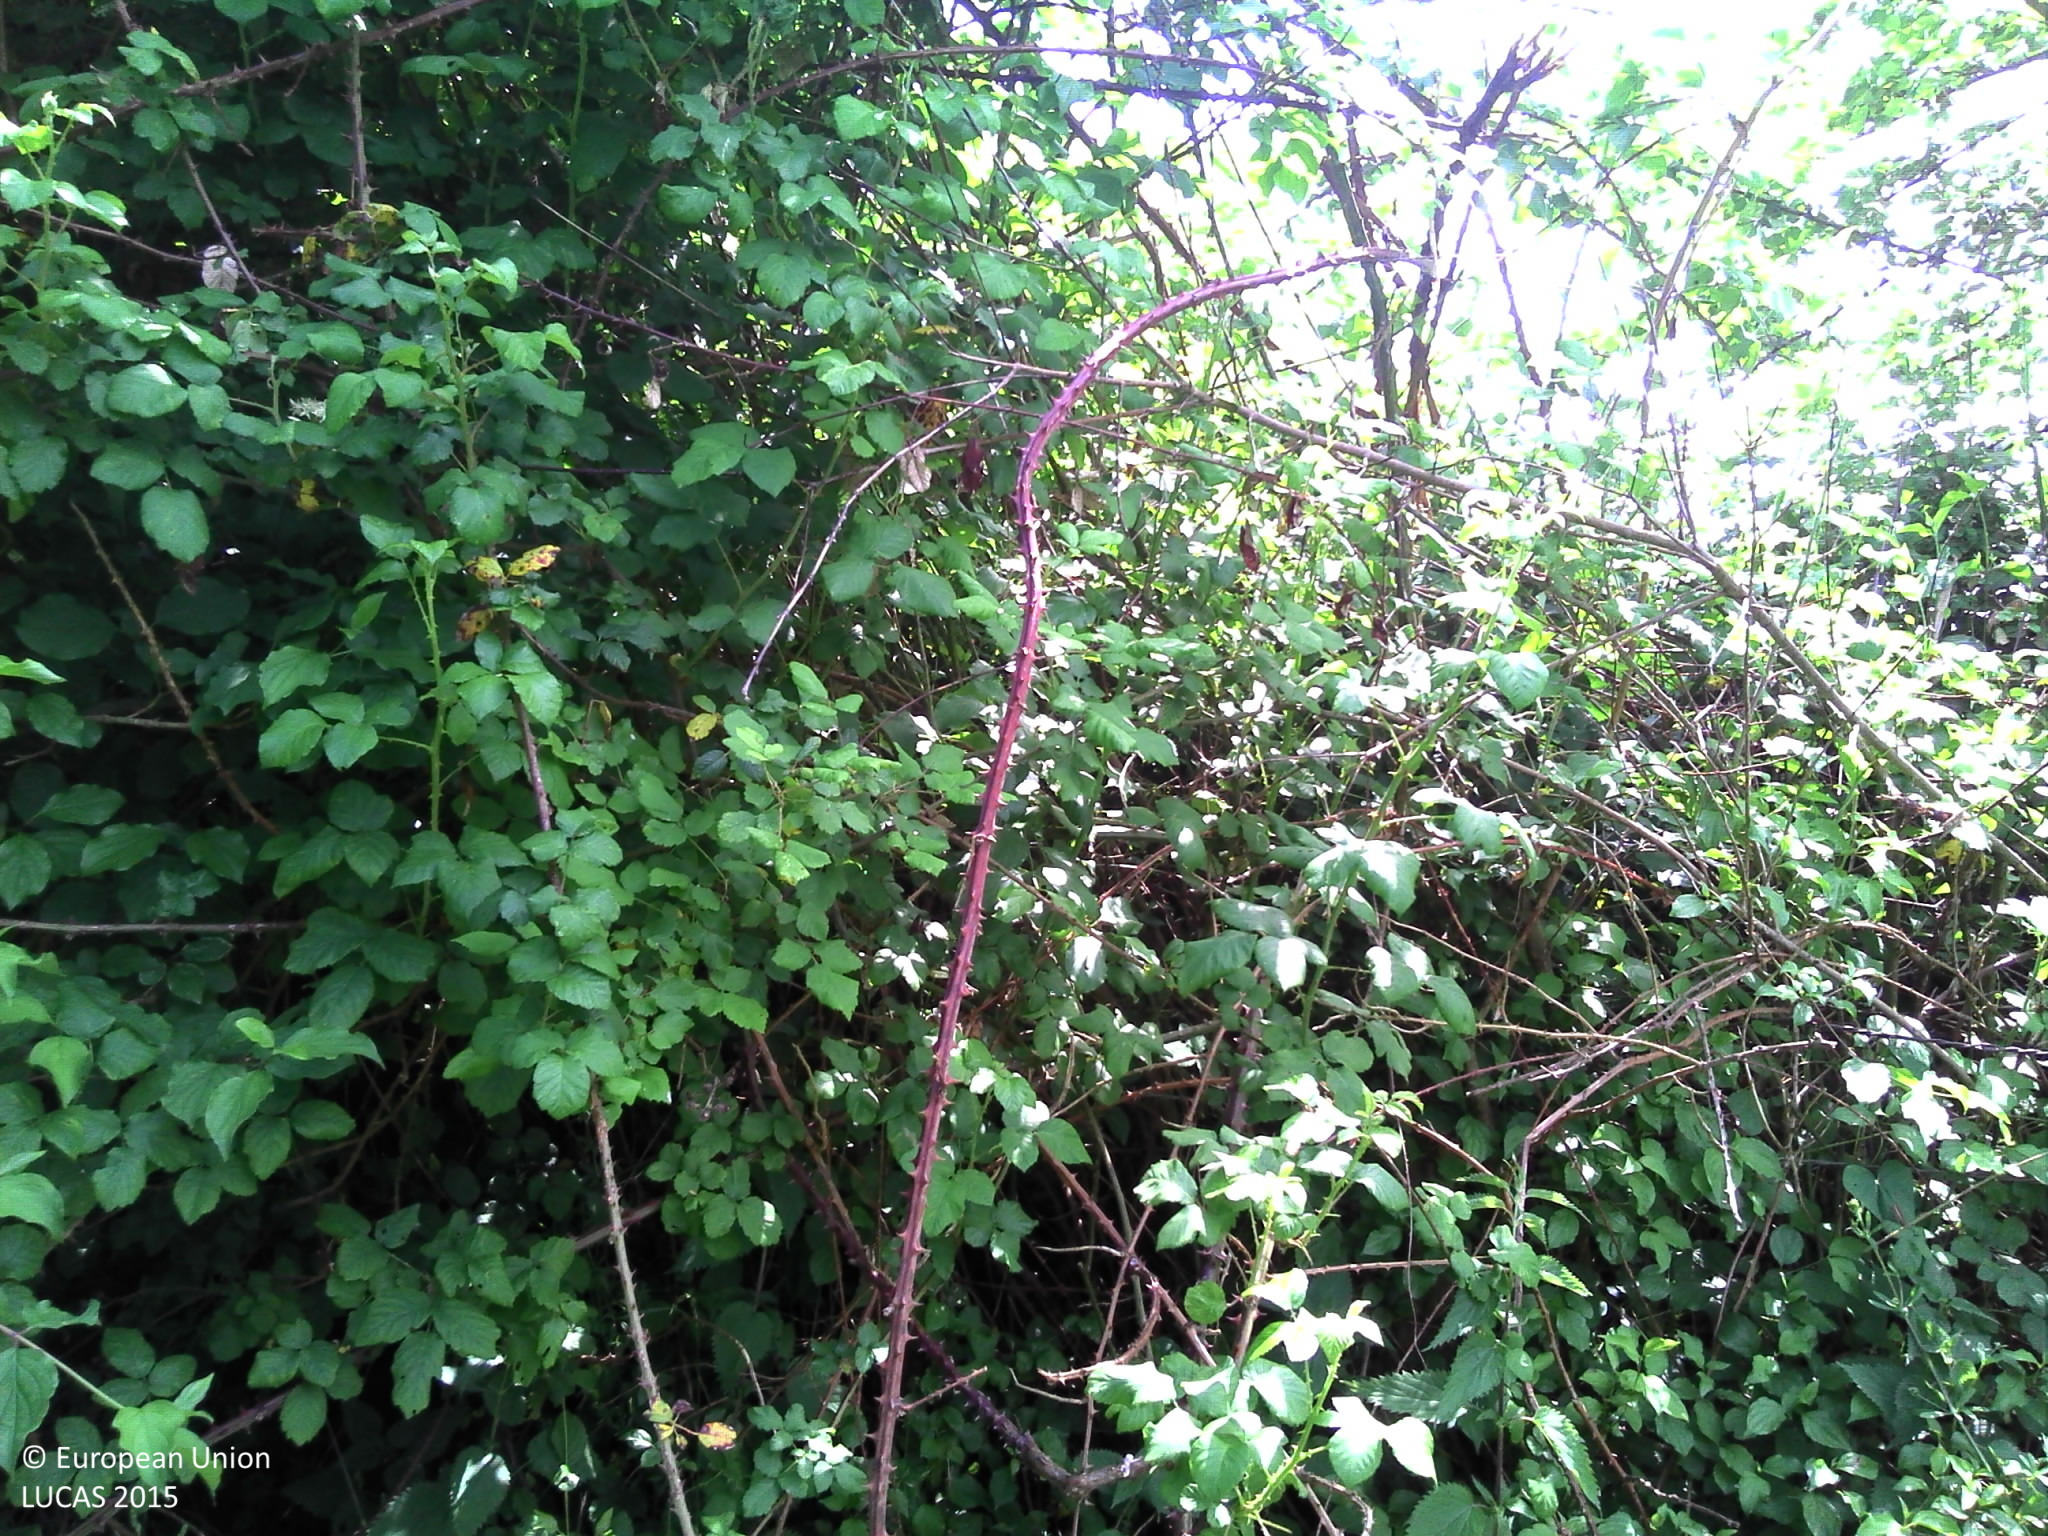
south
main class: Shrubland
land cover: Shrubland without tree cover
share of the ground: > 75 %
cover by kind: herbaceous plants 55 %, shrubs 45 %
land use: Agriculture (excluding fallow land and kitchen gardens)
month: May
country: FR
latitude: 47.0330
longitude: 0.0942
